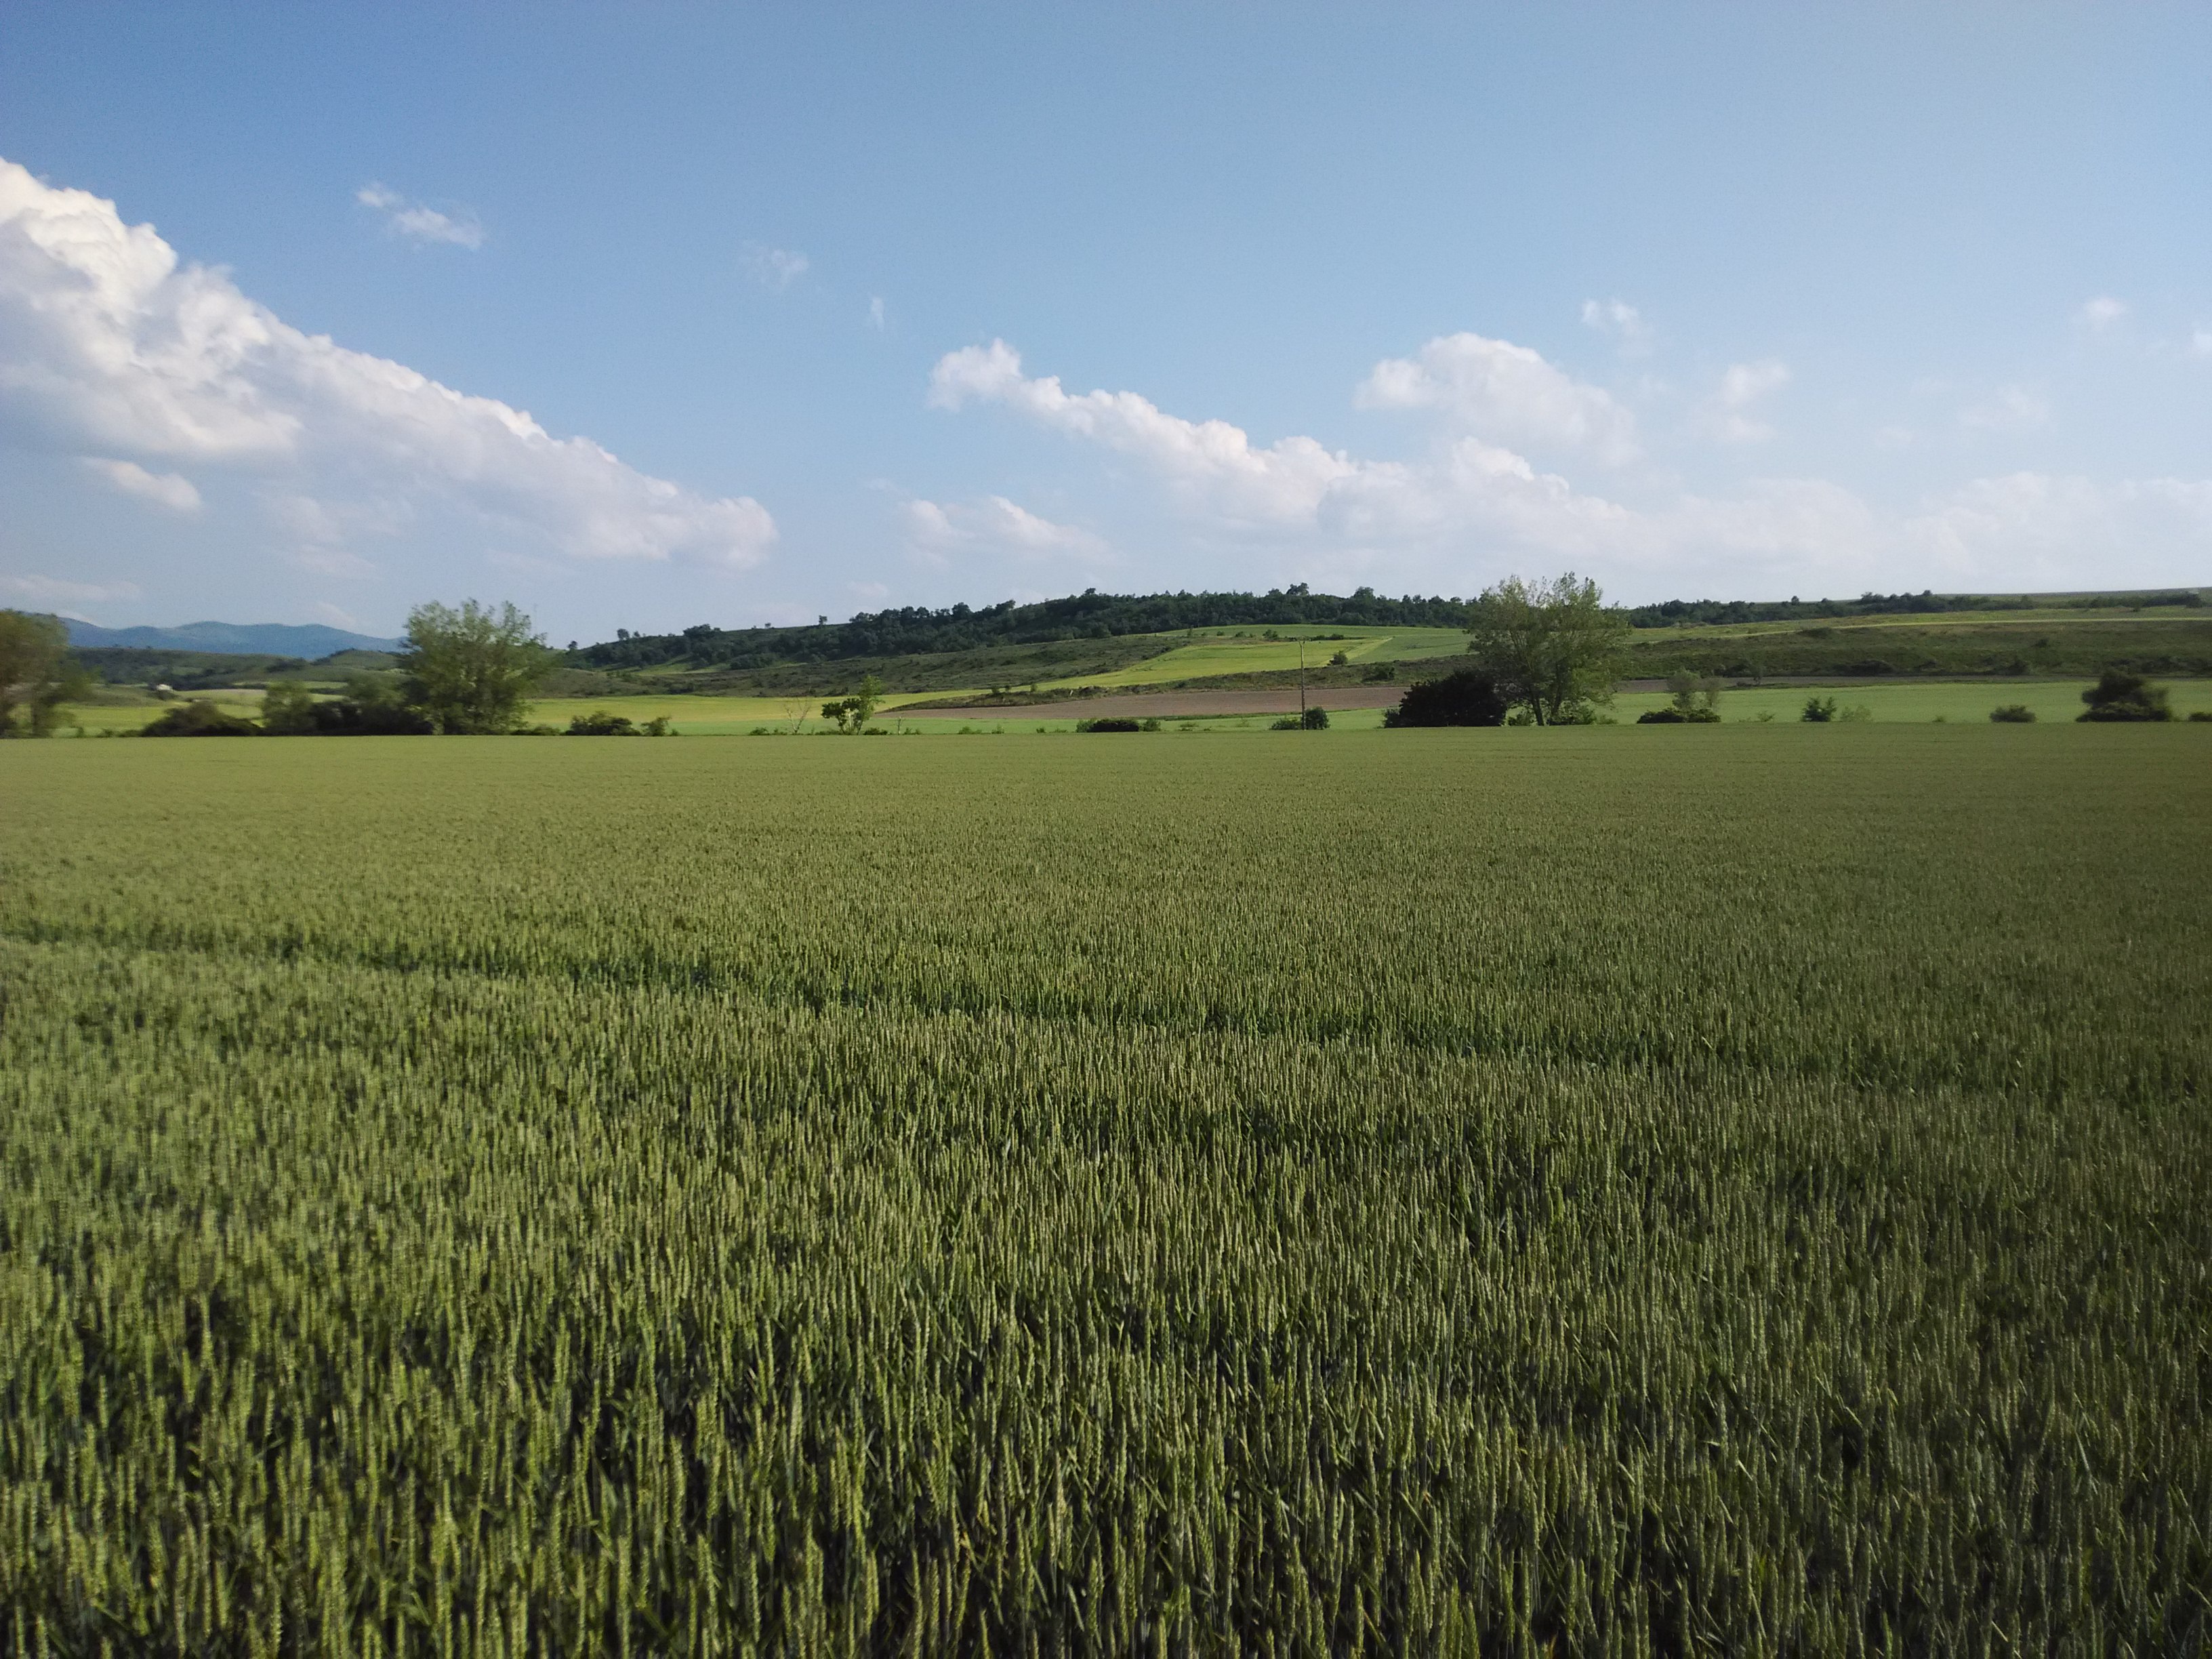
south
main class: Cropland
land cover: Common wheat
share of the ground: > 75 %
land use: Agriculture (excluding fallow land and kitchen gardens)
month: June
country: ES
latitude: 42.8830
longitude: -2.4763
